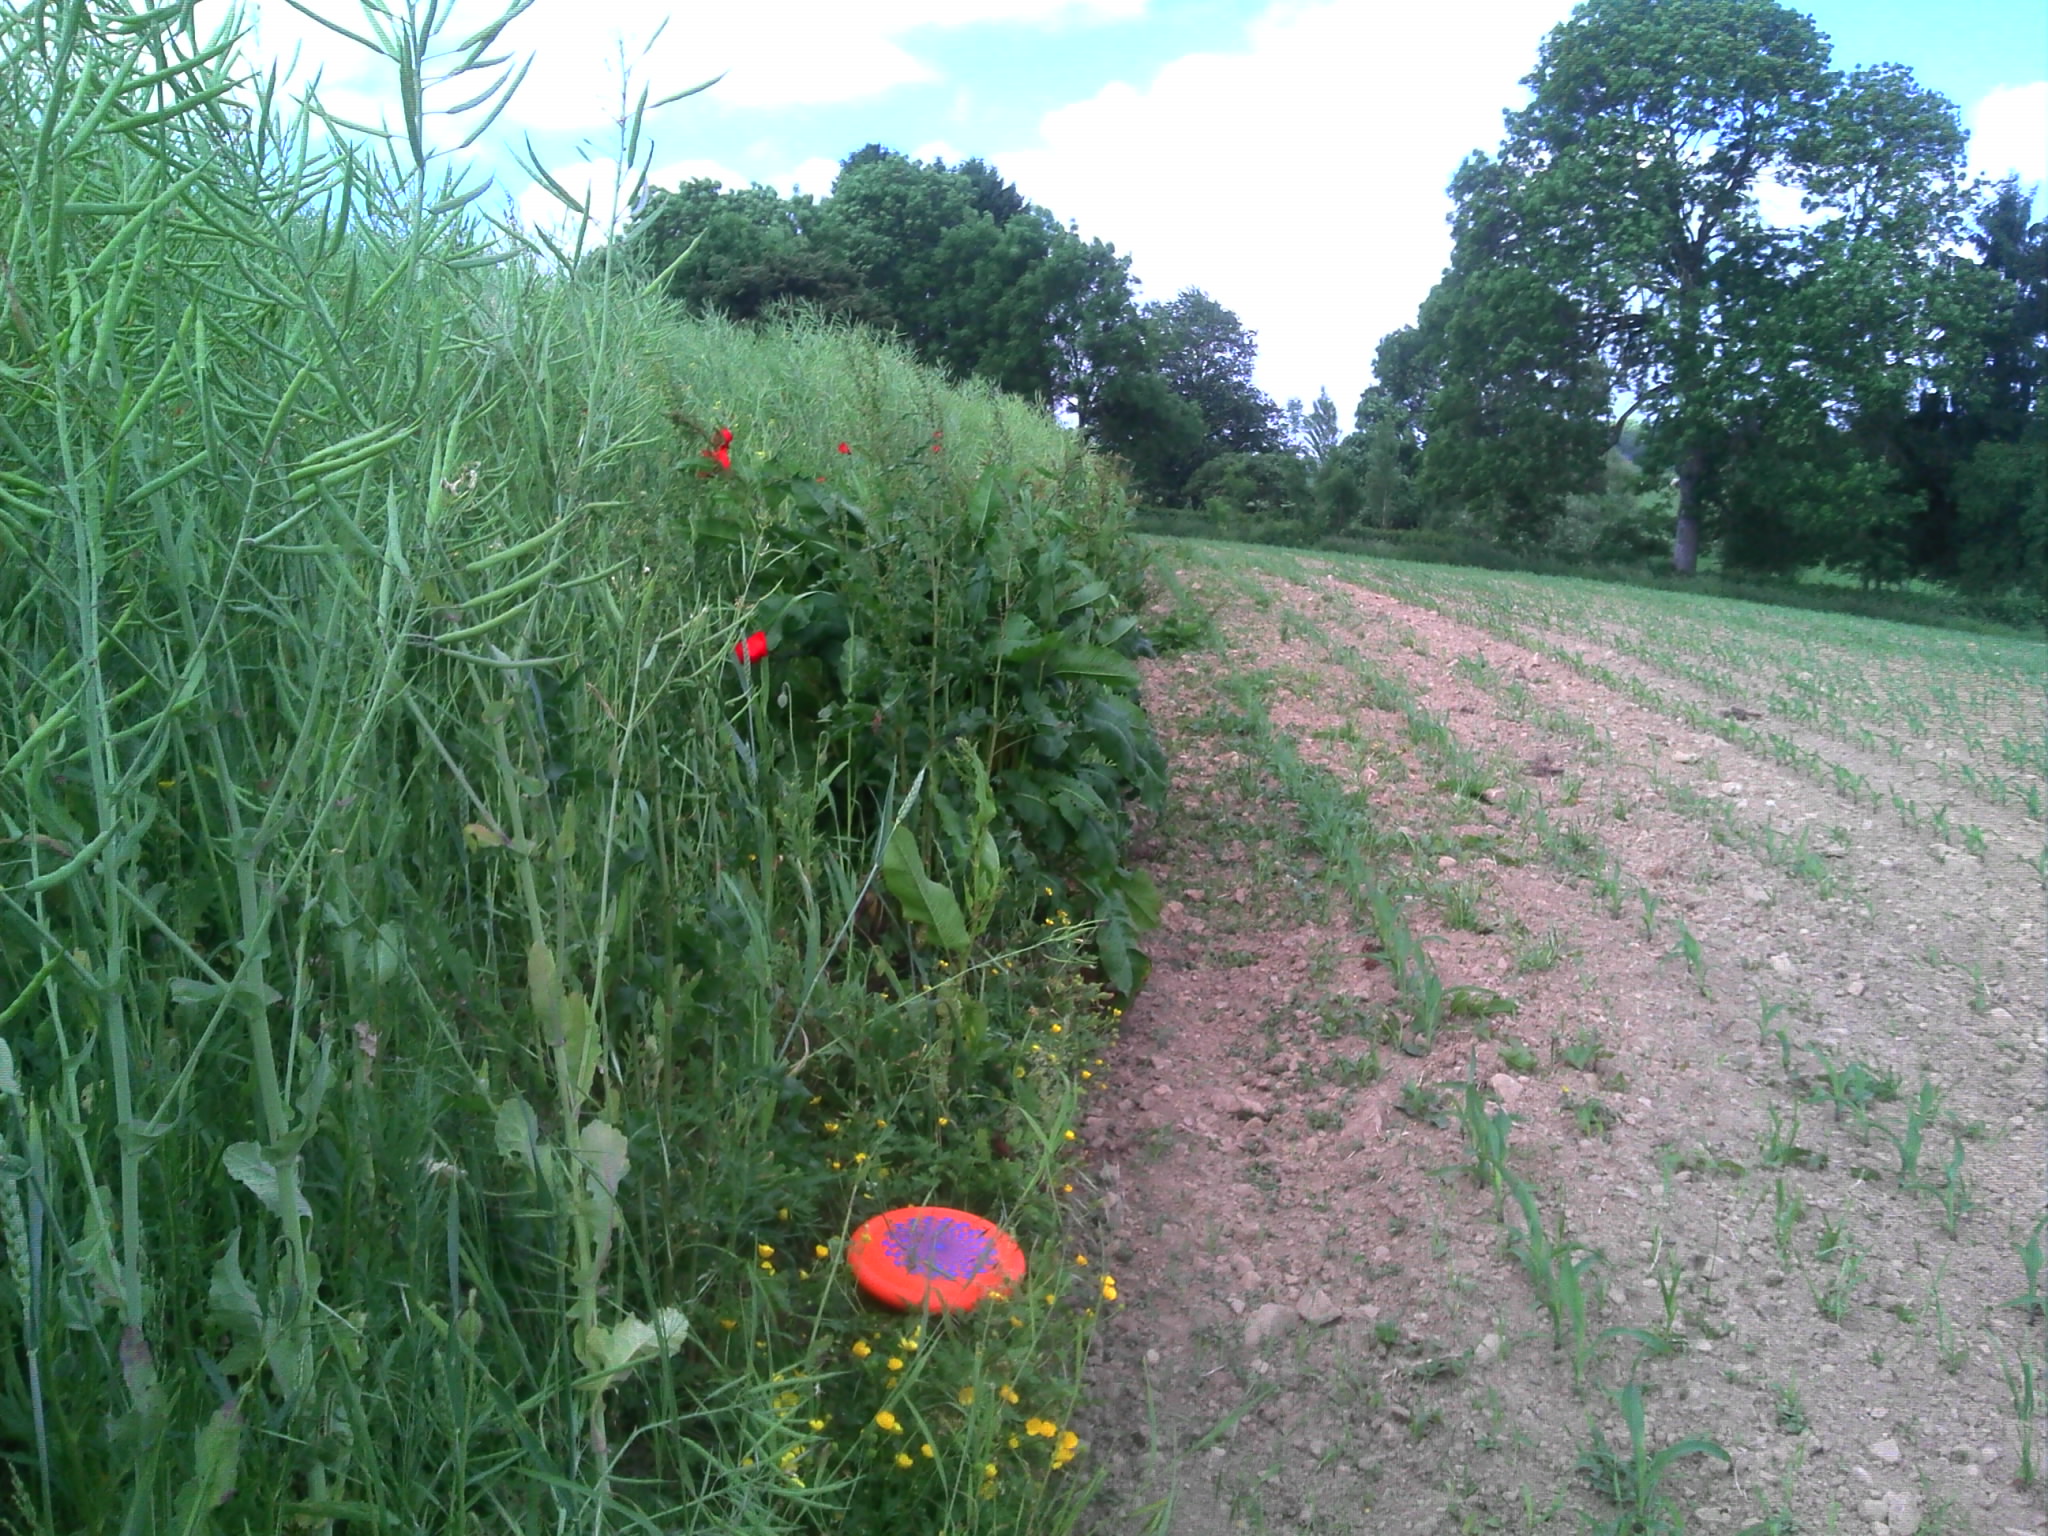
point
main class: Cropland
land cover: Rape and turnip rape
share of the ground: > 75 %
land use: Agriculture (excluding fallow land and kitchen gardens)
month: June
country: BE
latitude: 50.3583
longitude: 5.3172
